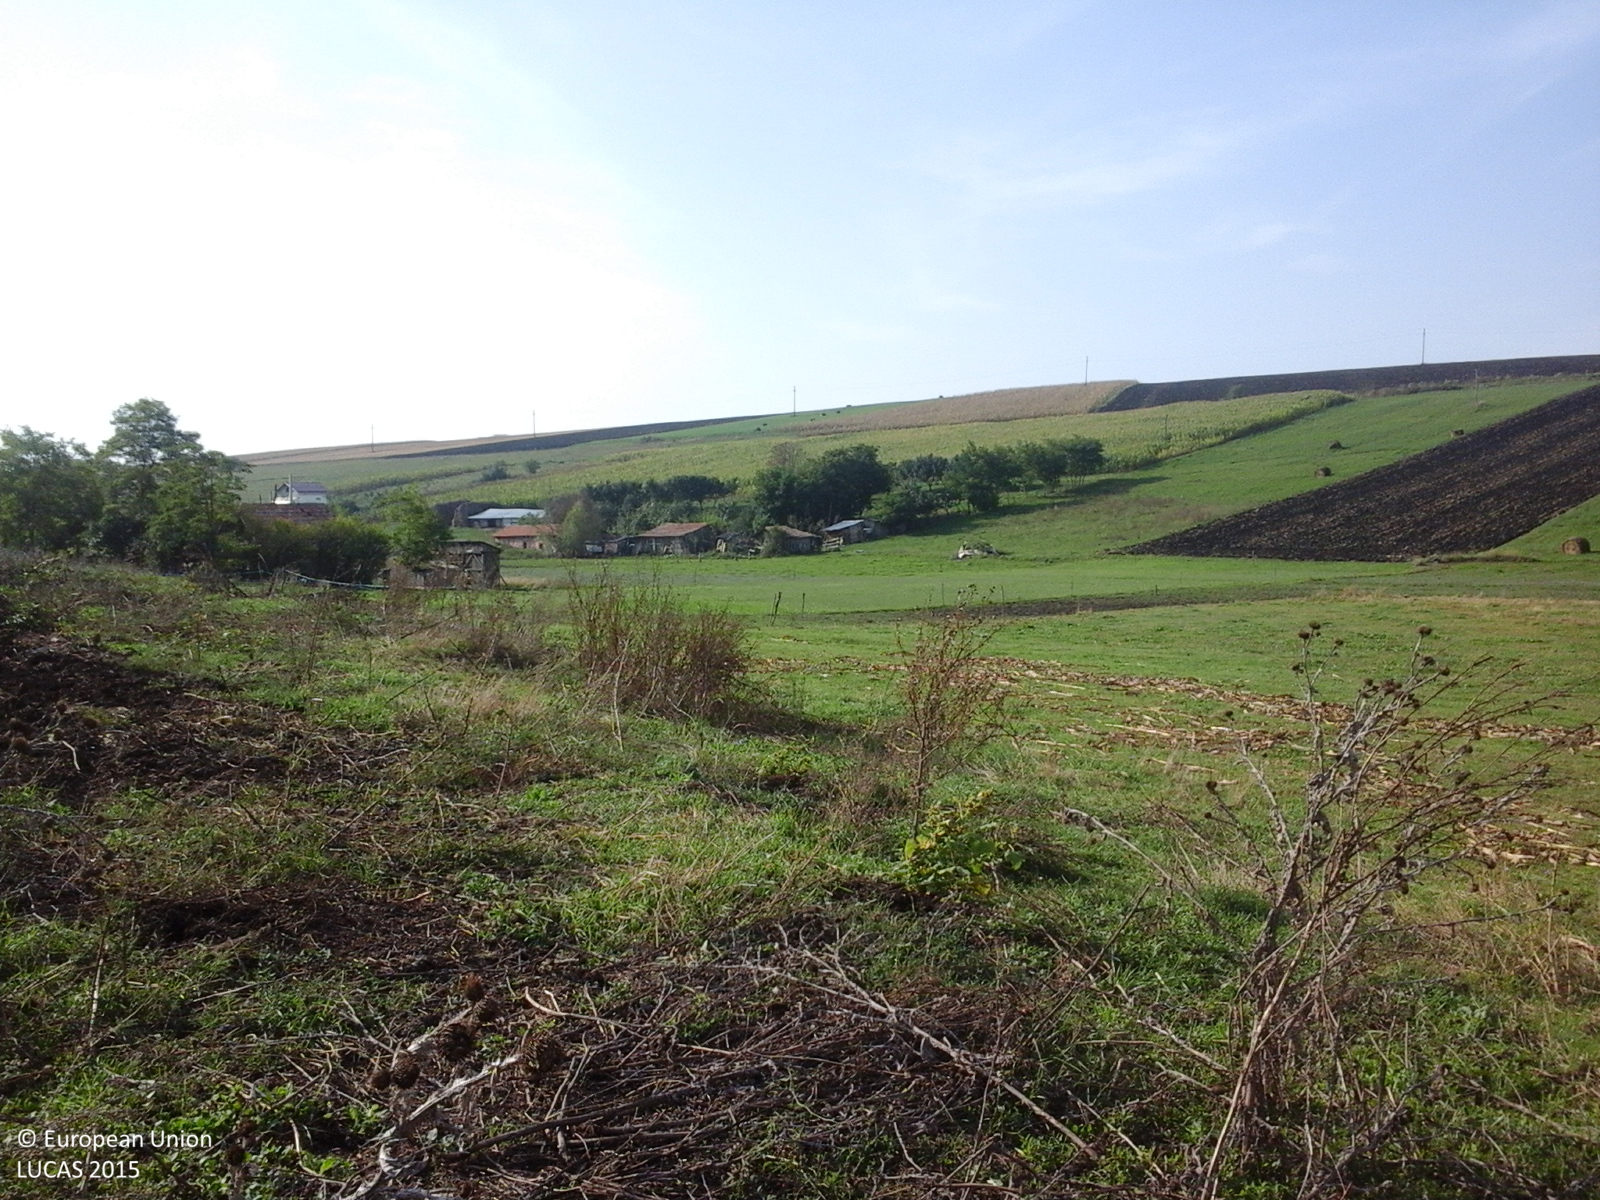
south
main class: Grassland
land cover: Grassland without tree/shrub cover
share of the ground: > 75 %
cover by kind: herbaceous plants 100 %
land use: Agriculture (excluding fallow land and kitchen gardens)
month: September
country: RO
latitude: 46.6523
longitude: 23.8340
